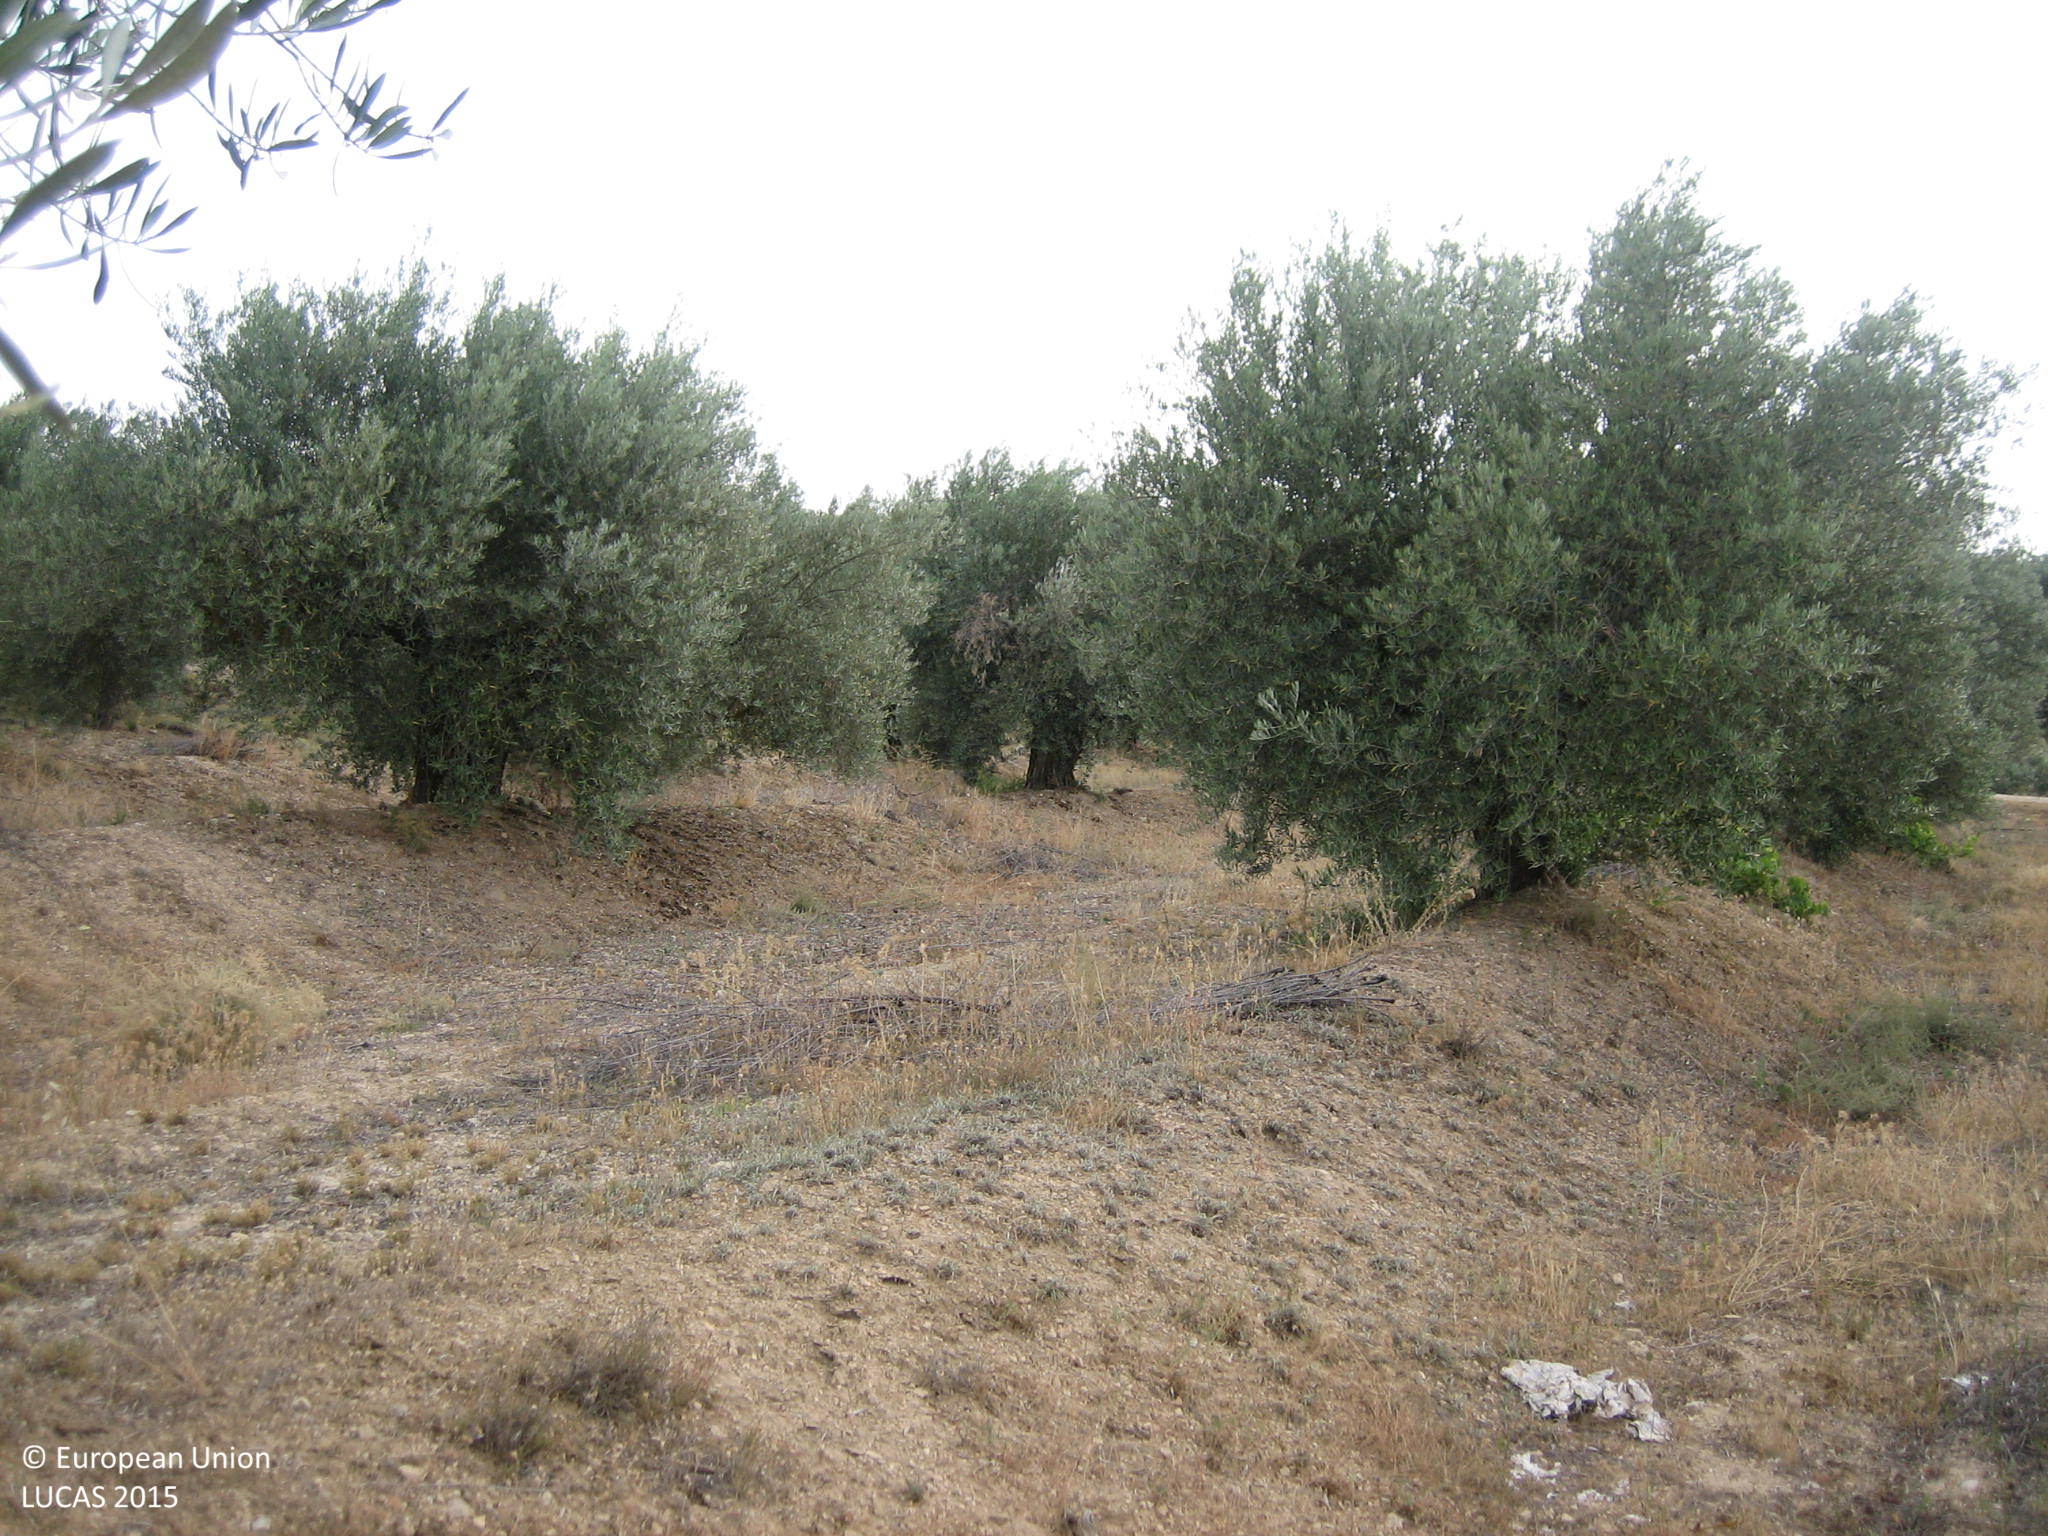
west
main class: Cropland
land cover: Olive groves
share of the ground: 10 - 25 %
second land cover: Spontaneously vegetated surfaces
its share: 50 - 75 %
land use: Agriculture (excluding fallow land and kitchen gardens)
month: July
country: ES
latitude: 37.6503
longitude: -2.9230
